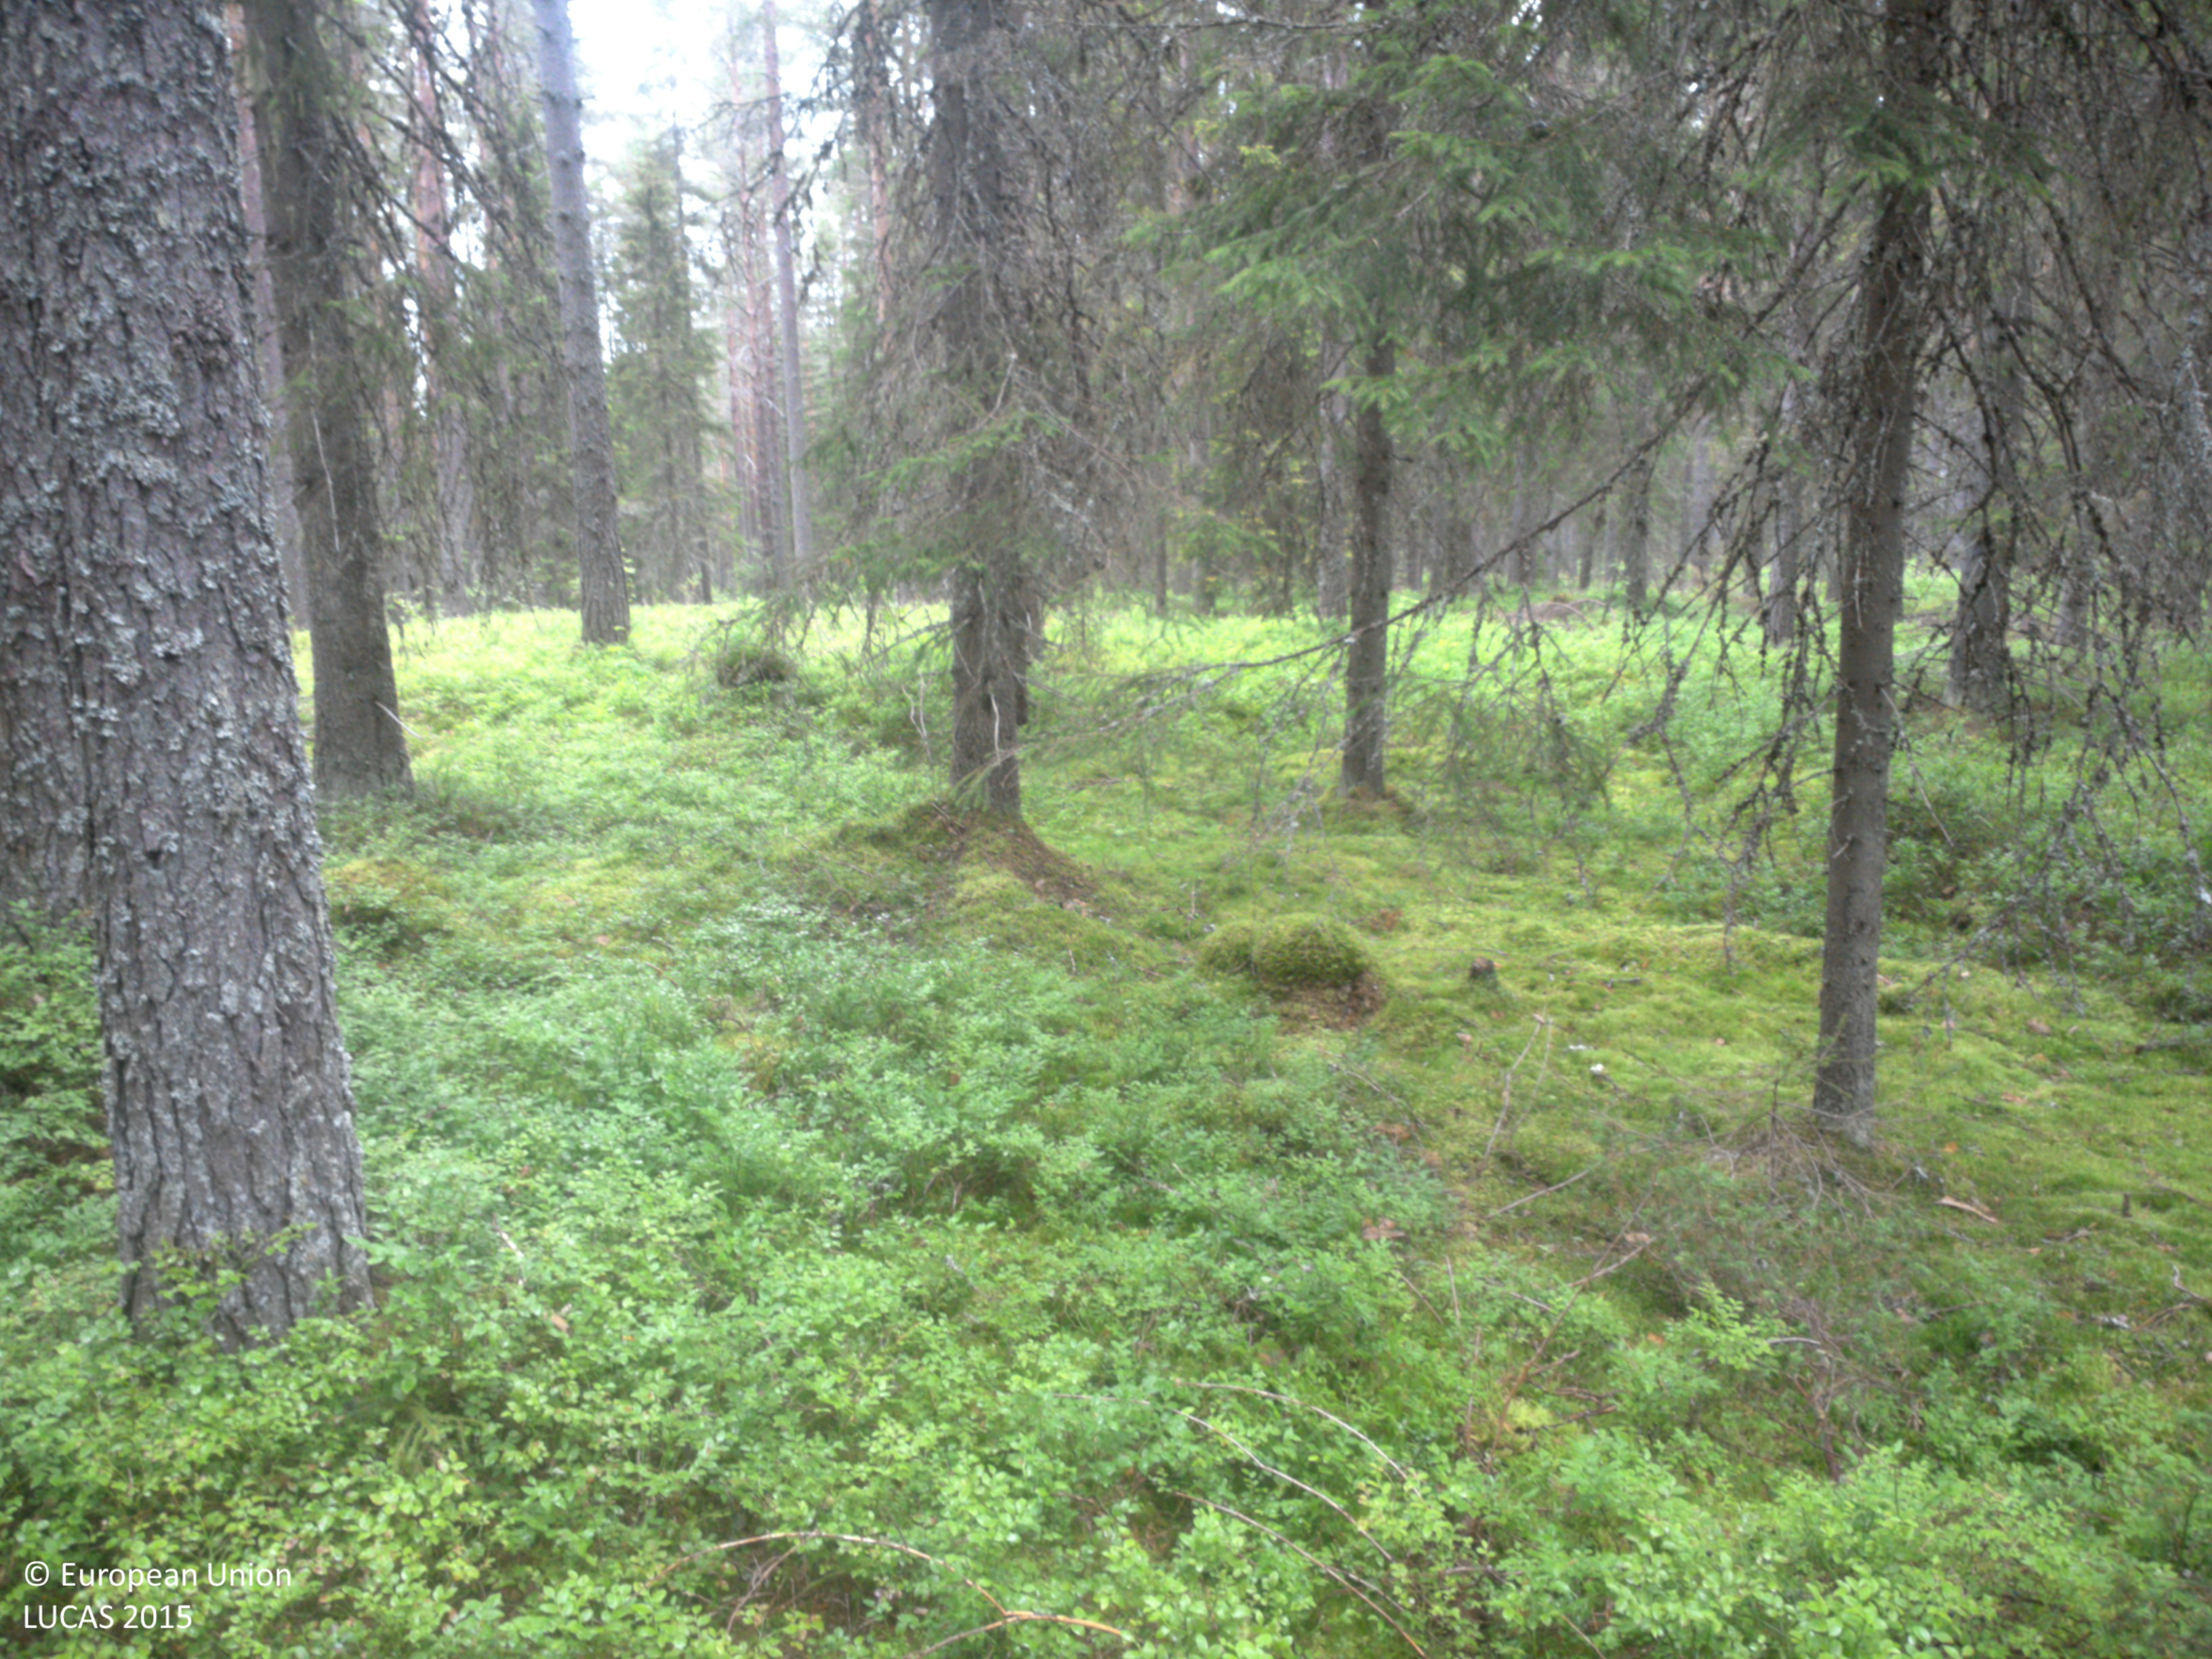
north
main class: Woodland
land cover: Other coniferous woodland
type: boreal forest
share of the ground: 50 - 75 %
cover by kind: coniferous forest trees 50 %, shrubs 40 %, lichens and mosses 10 %
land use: Forestry
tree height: > 5 m
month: August
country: SE
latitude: 63.7197
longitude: 19.6758
